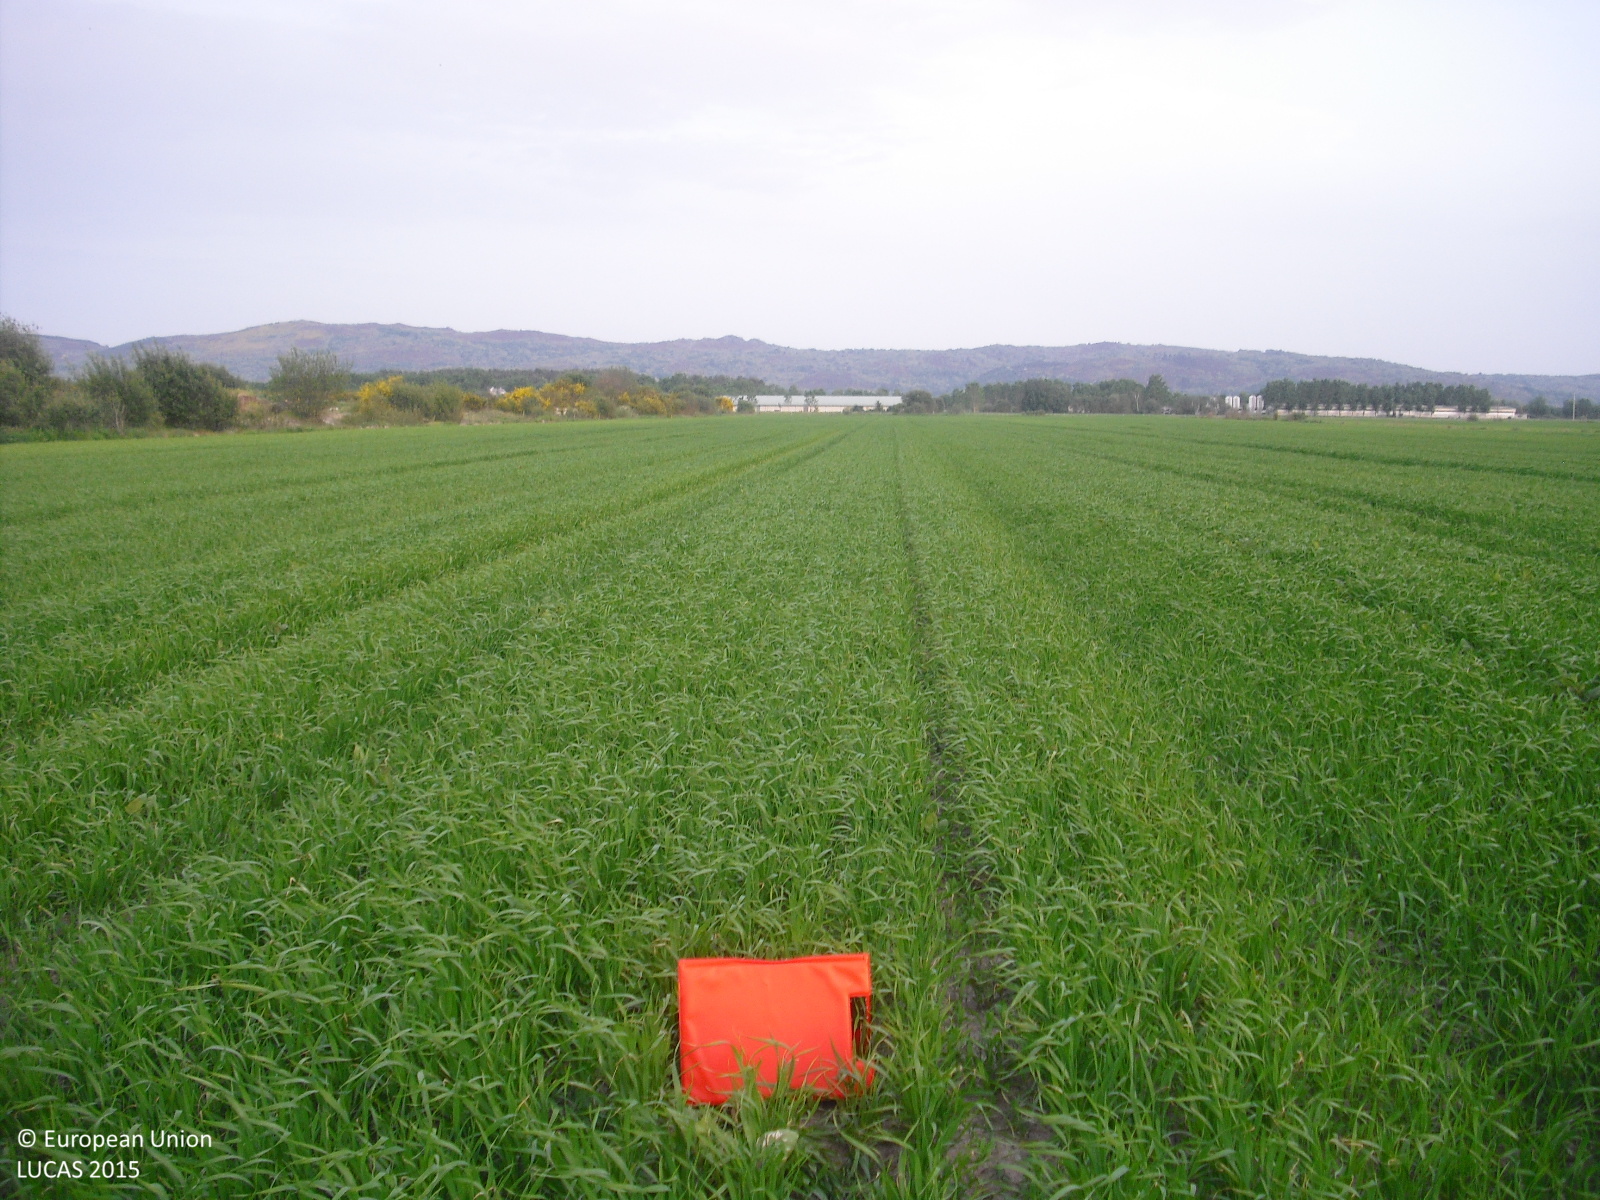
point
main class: Cropland
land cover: Common wheat
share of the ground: > 75 %
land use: Agriculture (excluding fallow land and kitchen gardens)
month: May
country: ES
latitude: 42.1367
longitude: -7.6726
